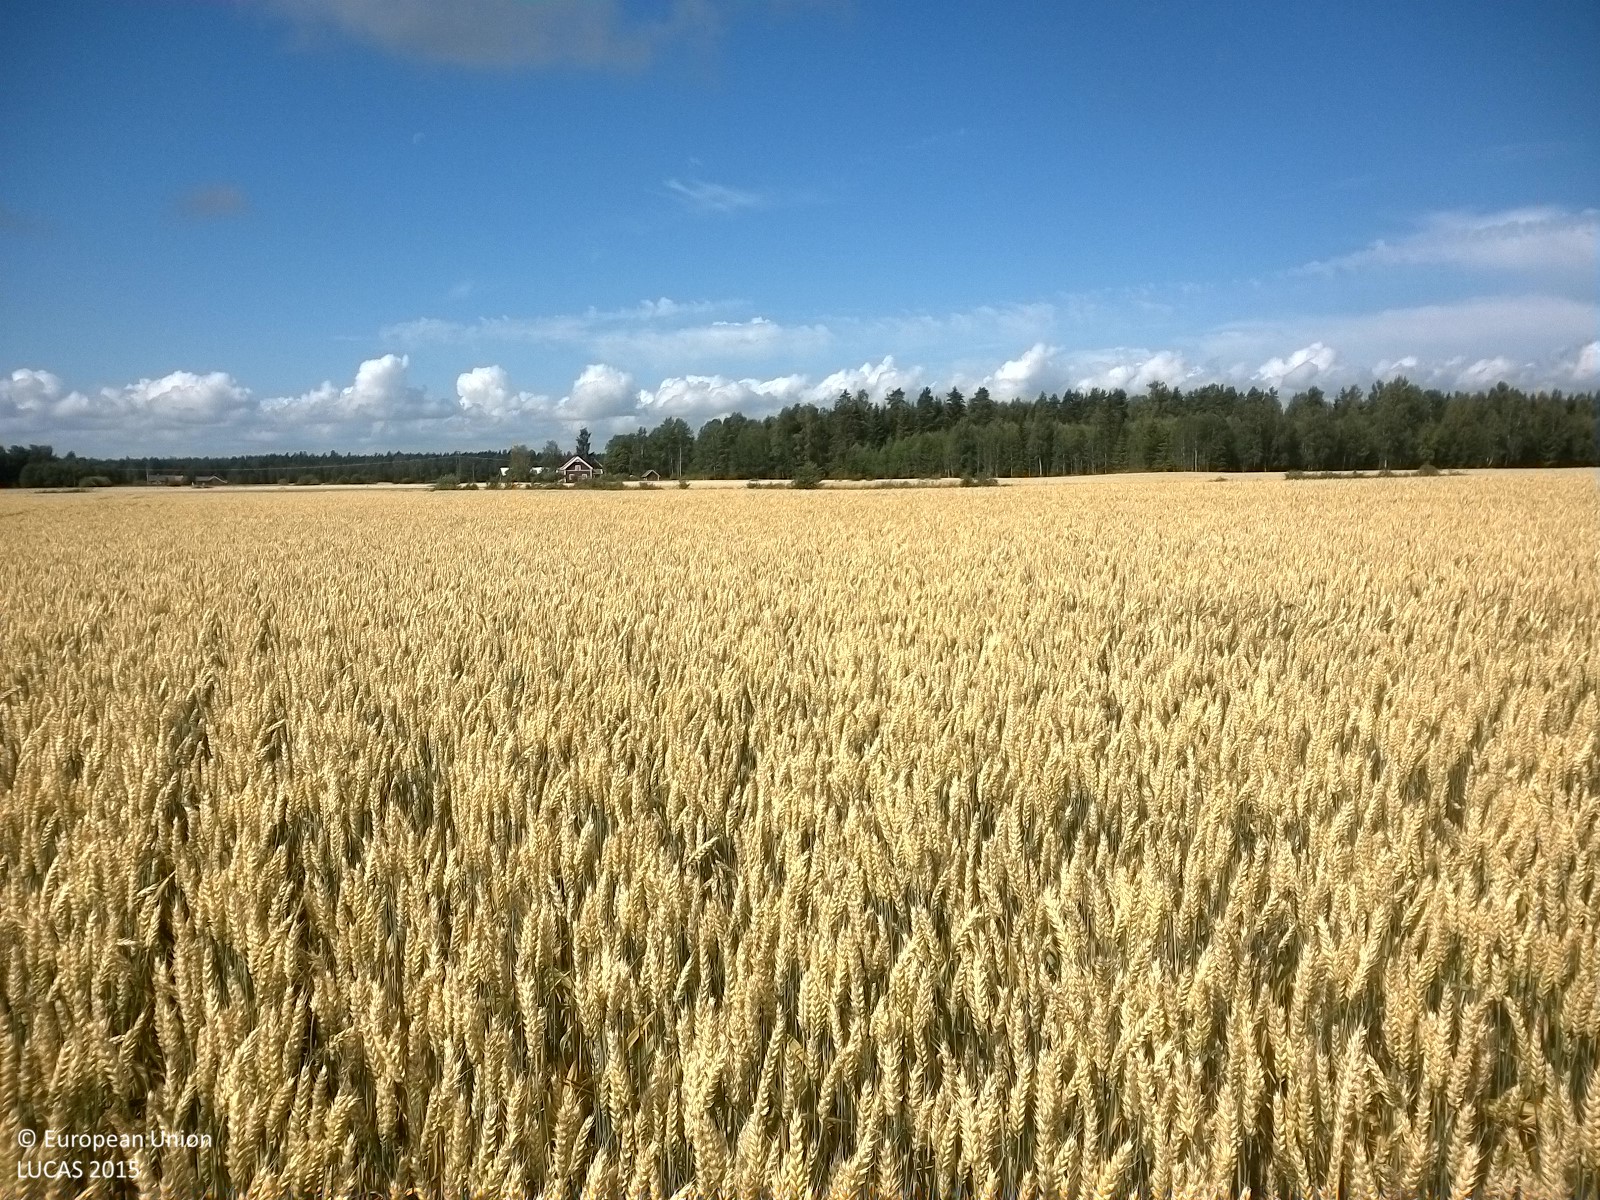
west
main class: Cropland
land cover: Common wheat
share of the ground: > 75 %
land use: Agriculture (excluding fallow land and kitchen gardens)
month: August
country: SE
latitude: 59.1692
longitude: 15.0824
